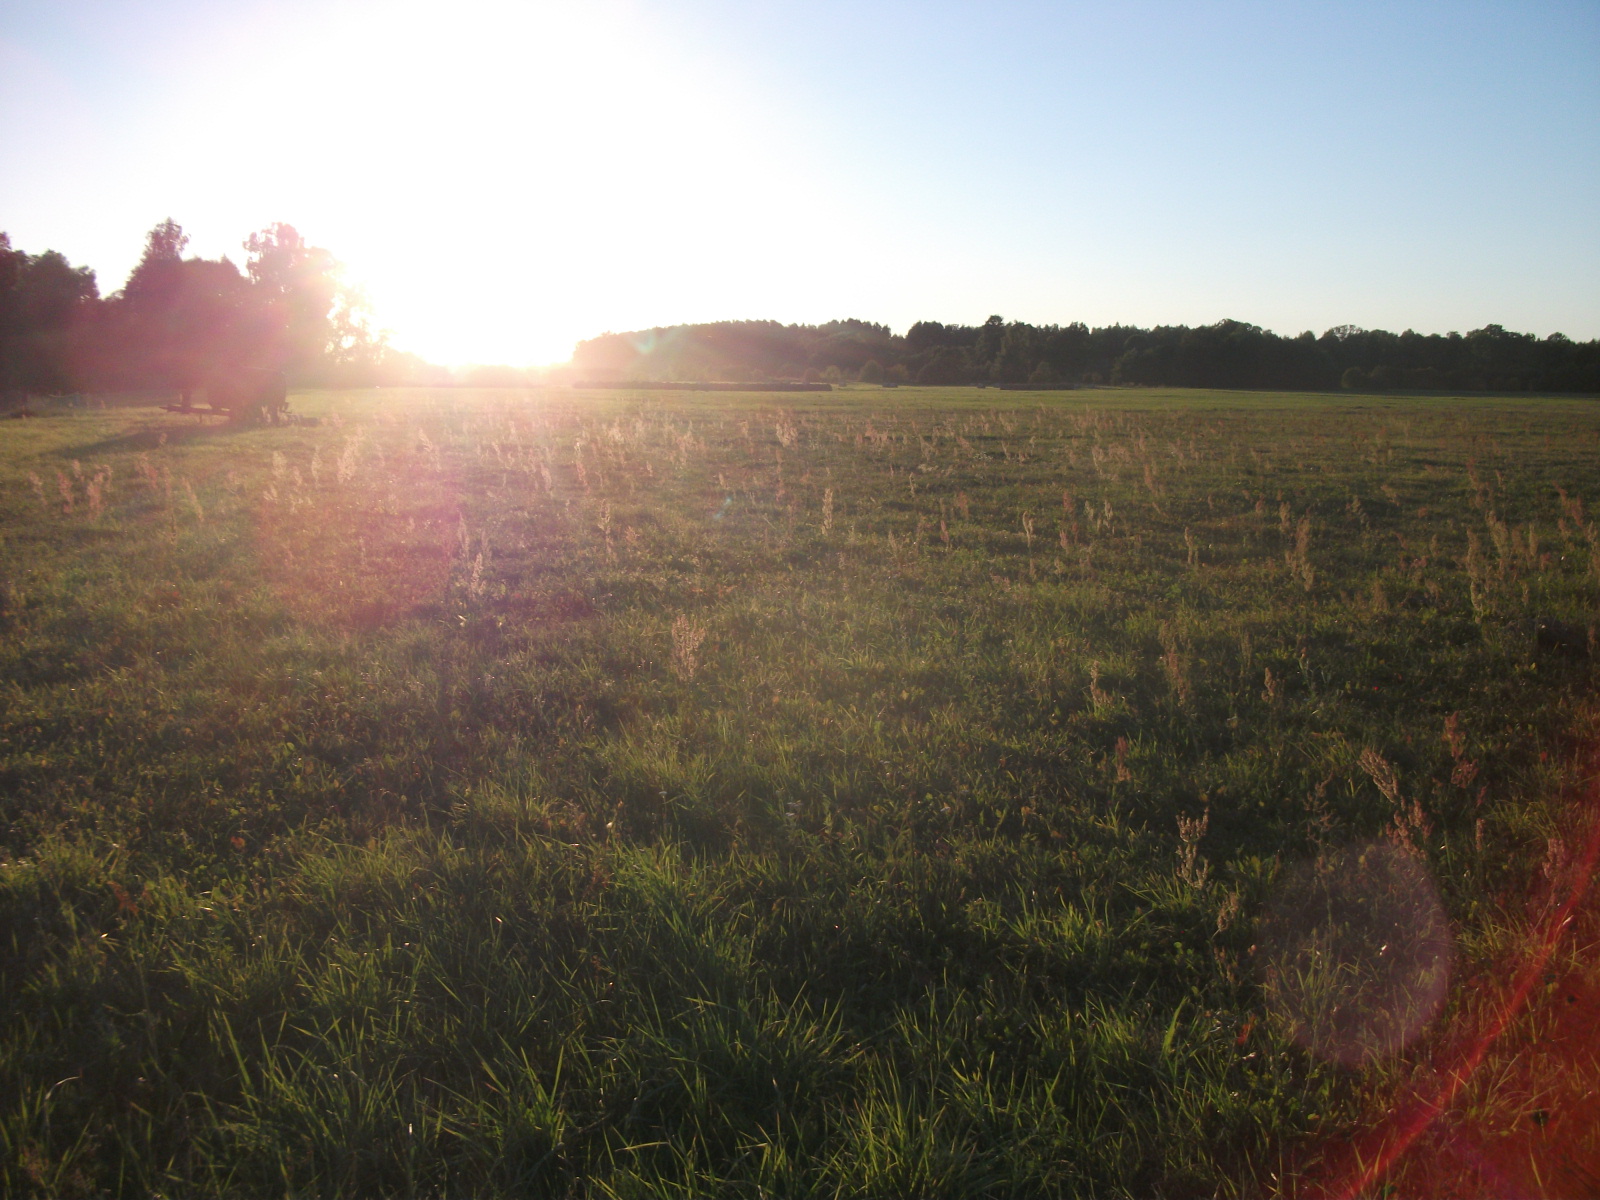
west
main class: Grassland
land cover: Grassland without tree/shrub cover
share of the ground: > 75 %
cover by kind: herbaceous plants 100 %
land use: Agriculture (excluding fallow land and kitchen gardens)
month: August
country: LV
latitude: 56.3479
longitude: 26.3073
